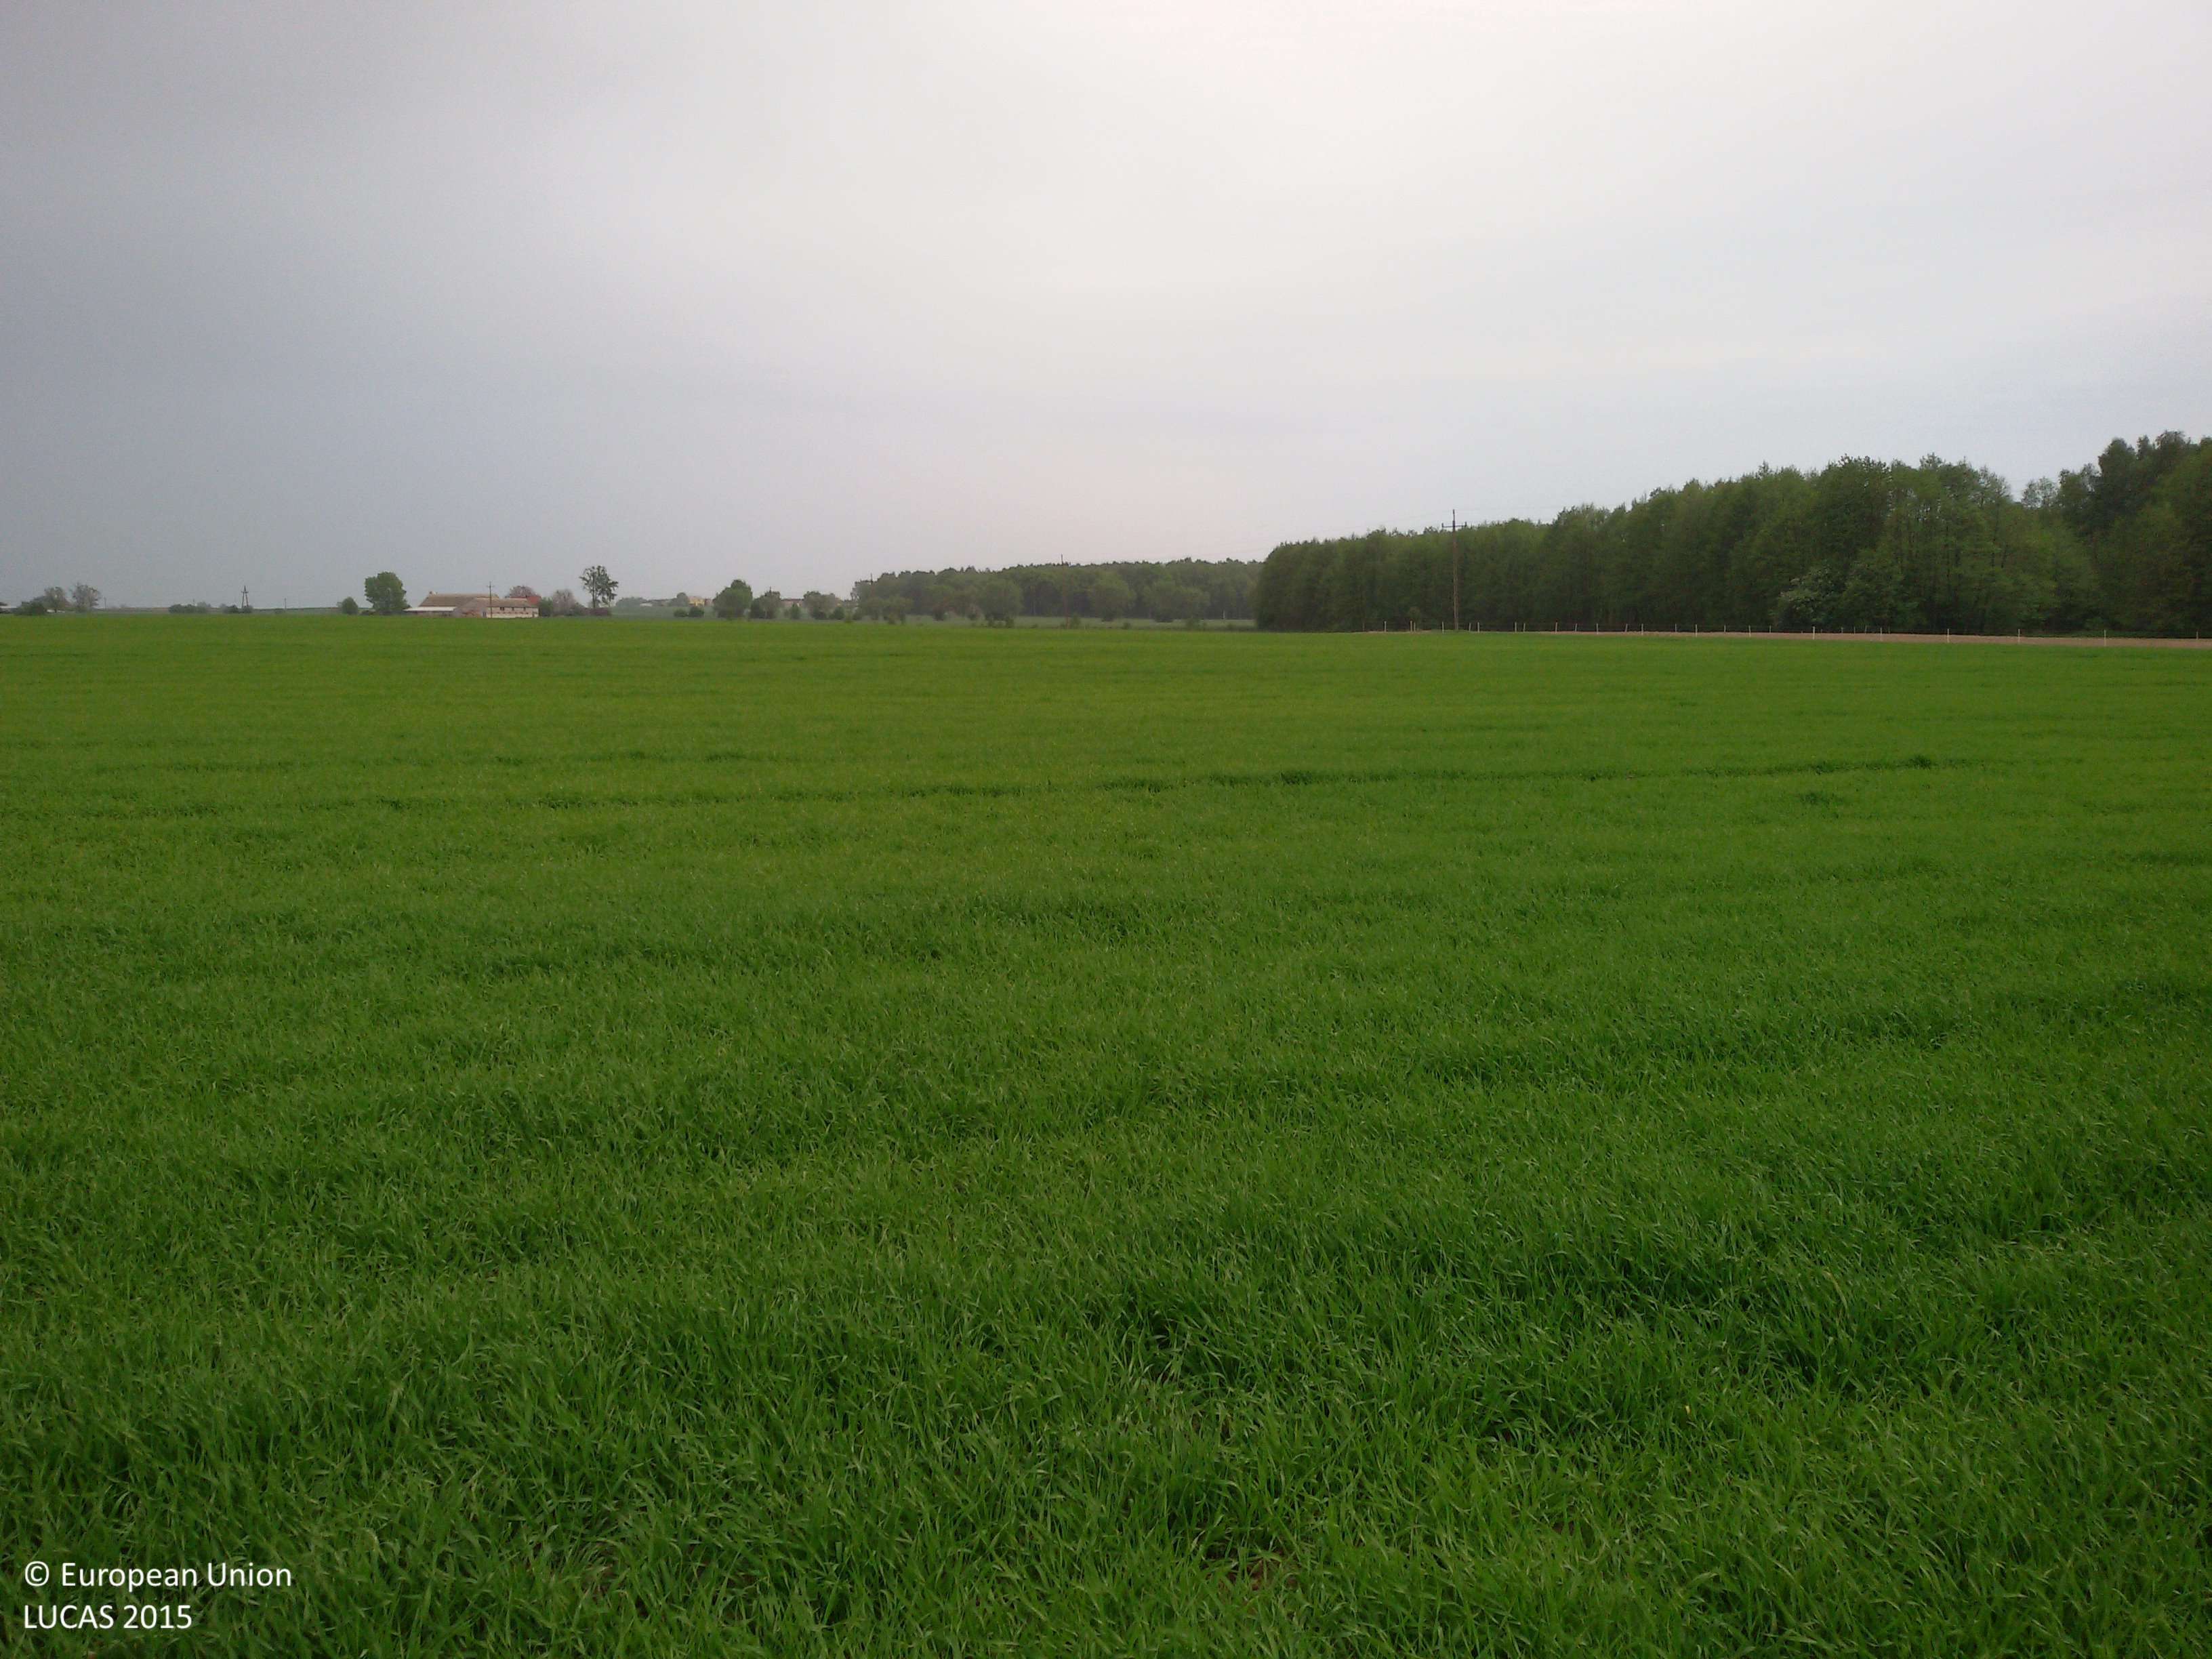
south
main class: Cropland
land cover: Barley
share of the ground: > 75 %
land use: Agriculture (excluding fallow land and kitchen gardens)
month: May
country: PL
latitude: 52.9351
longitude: 17.1967
